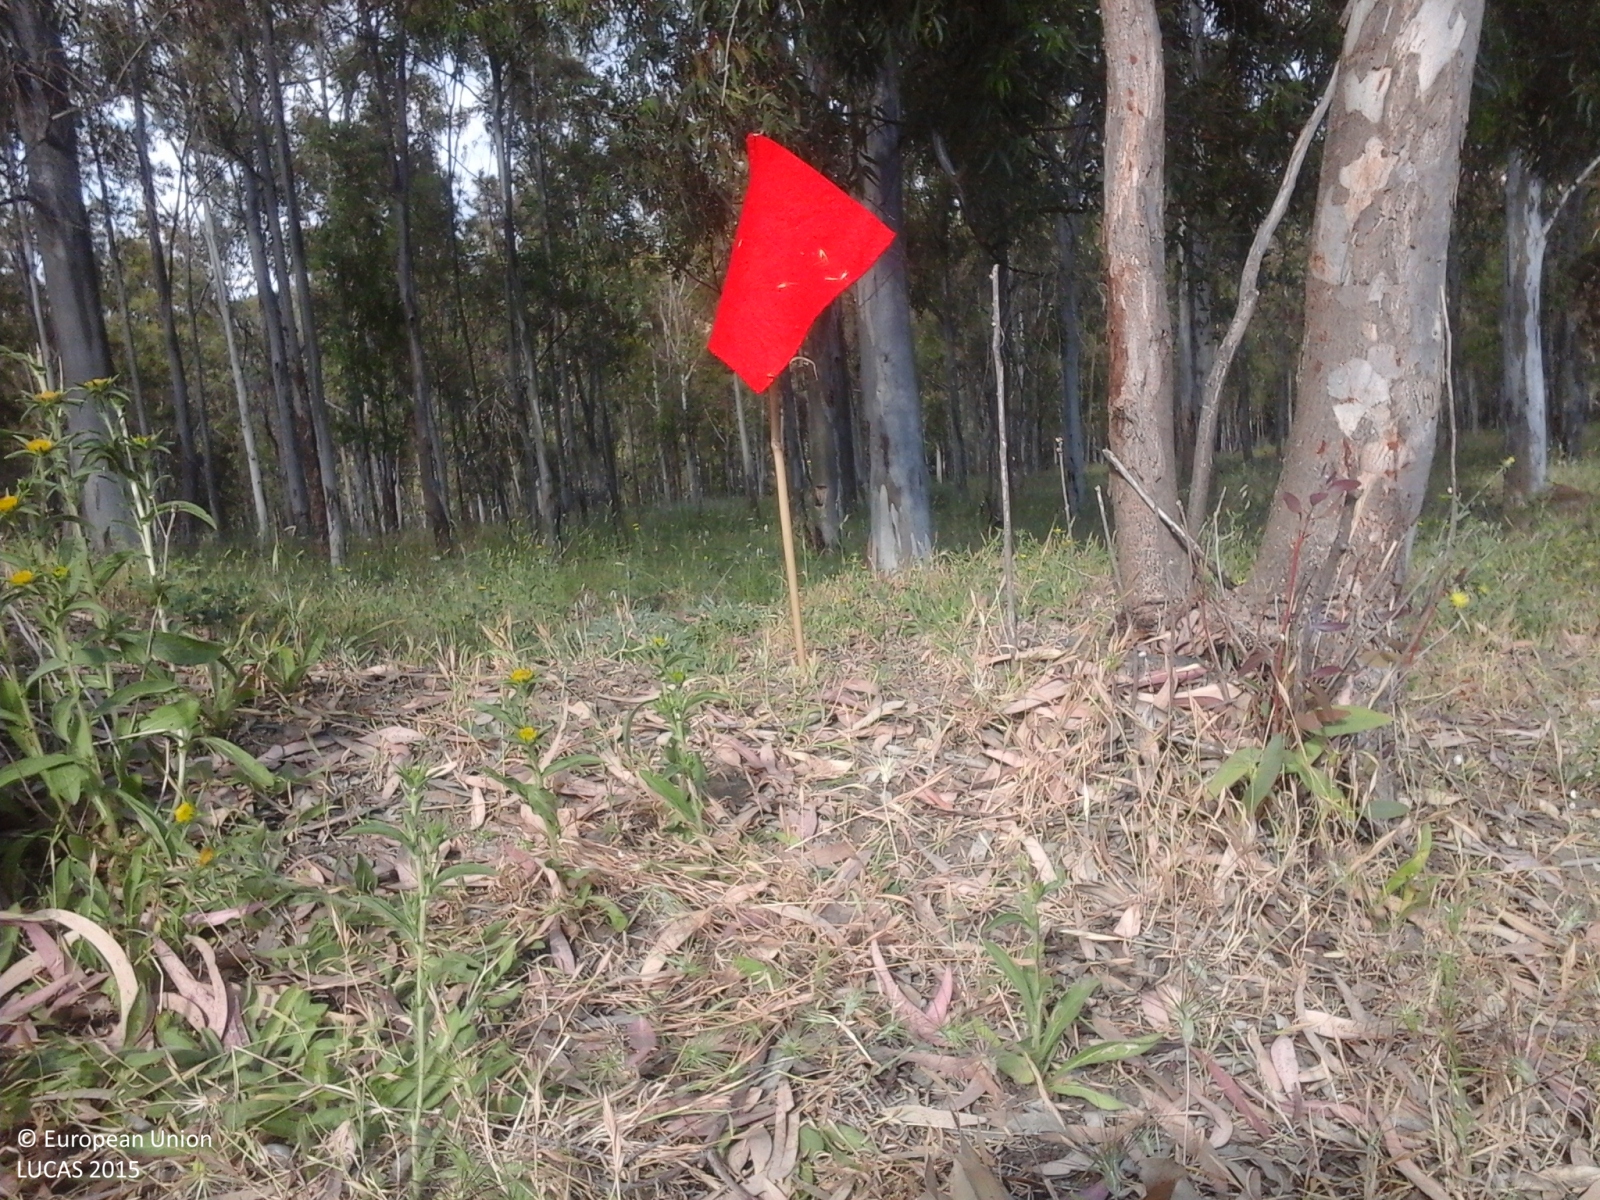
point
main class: Woodland
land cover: Broadleaved woodland
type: exotic forest
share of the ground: > 75 %
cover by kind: broadleaved forest trees 100 %
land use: Forestry
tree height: > 5 m
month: May
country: IT
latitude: 37.5672
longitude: 14.1246
